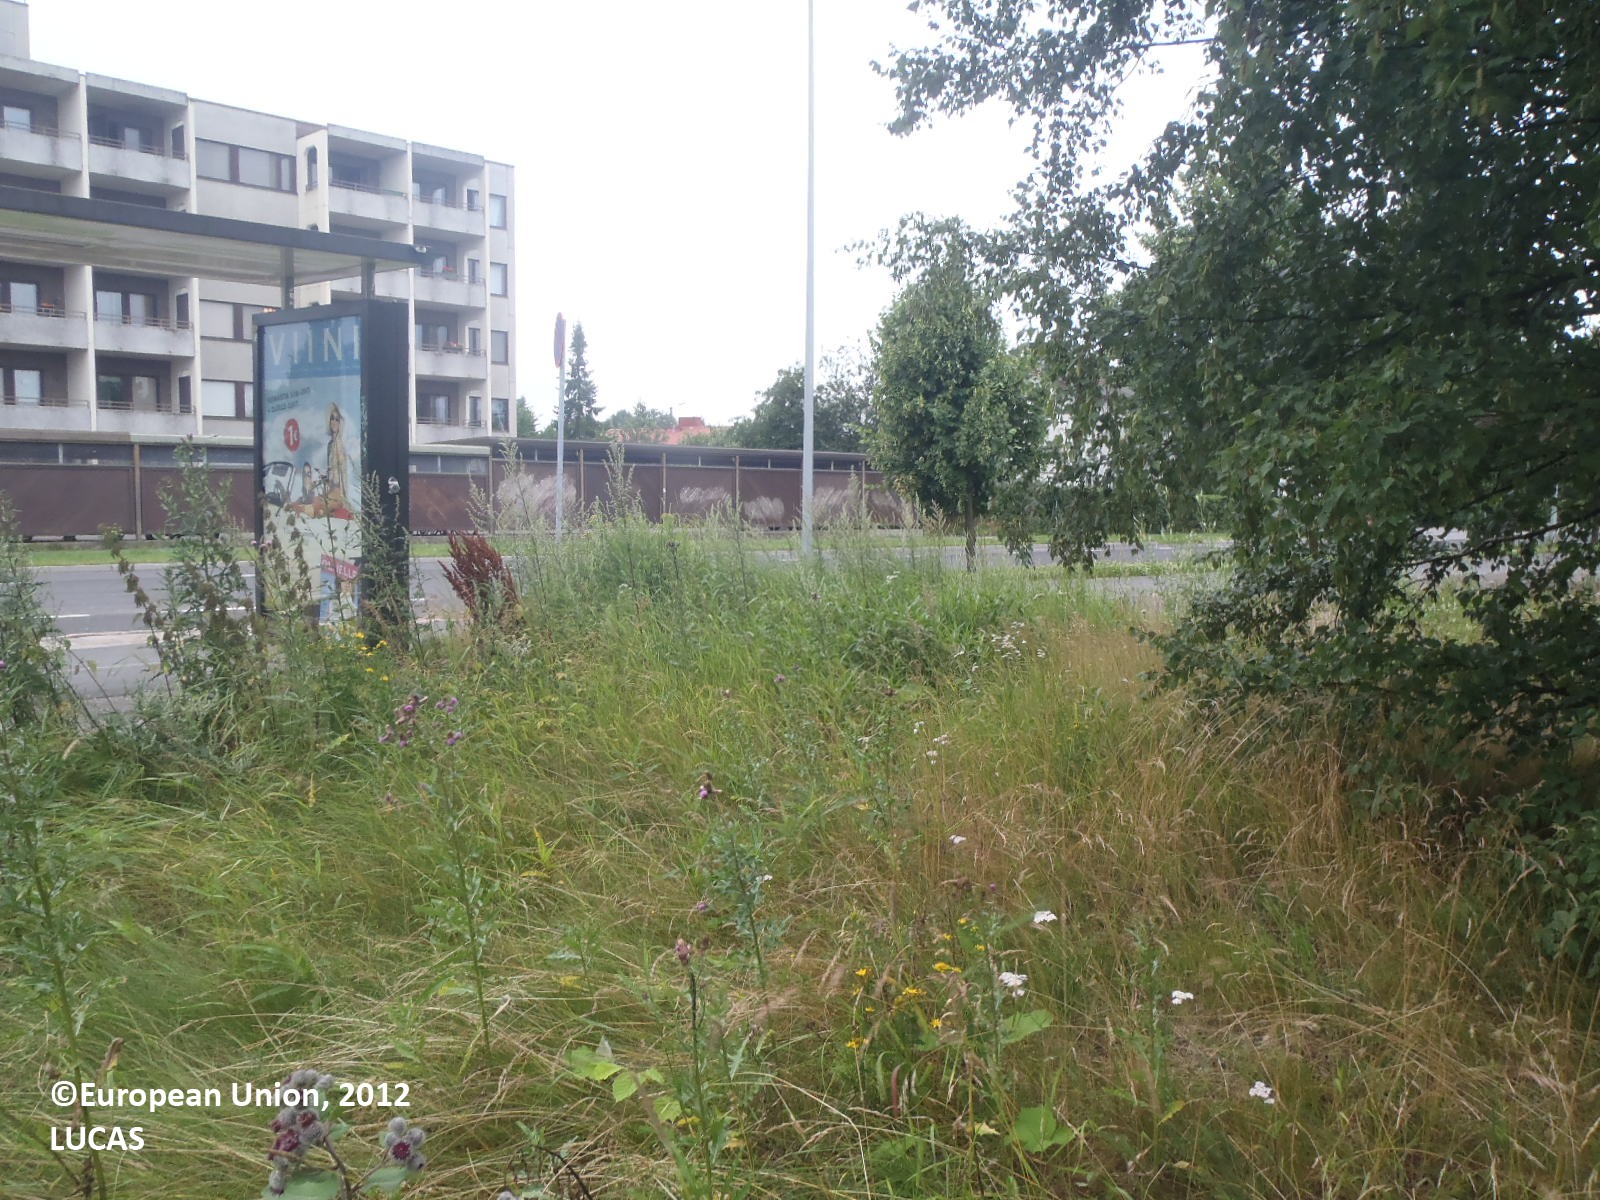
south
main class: Grassland
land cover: Grassland without tree/shrub cover
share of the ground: > 75 %
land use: Abandoned areas
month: July
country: FI
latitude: 60.4432
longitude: 22.2985
